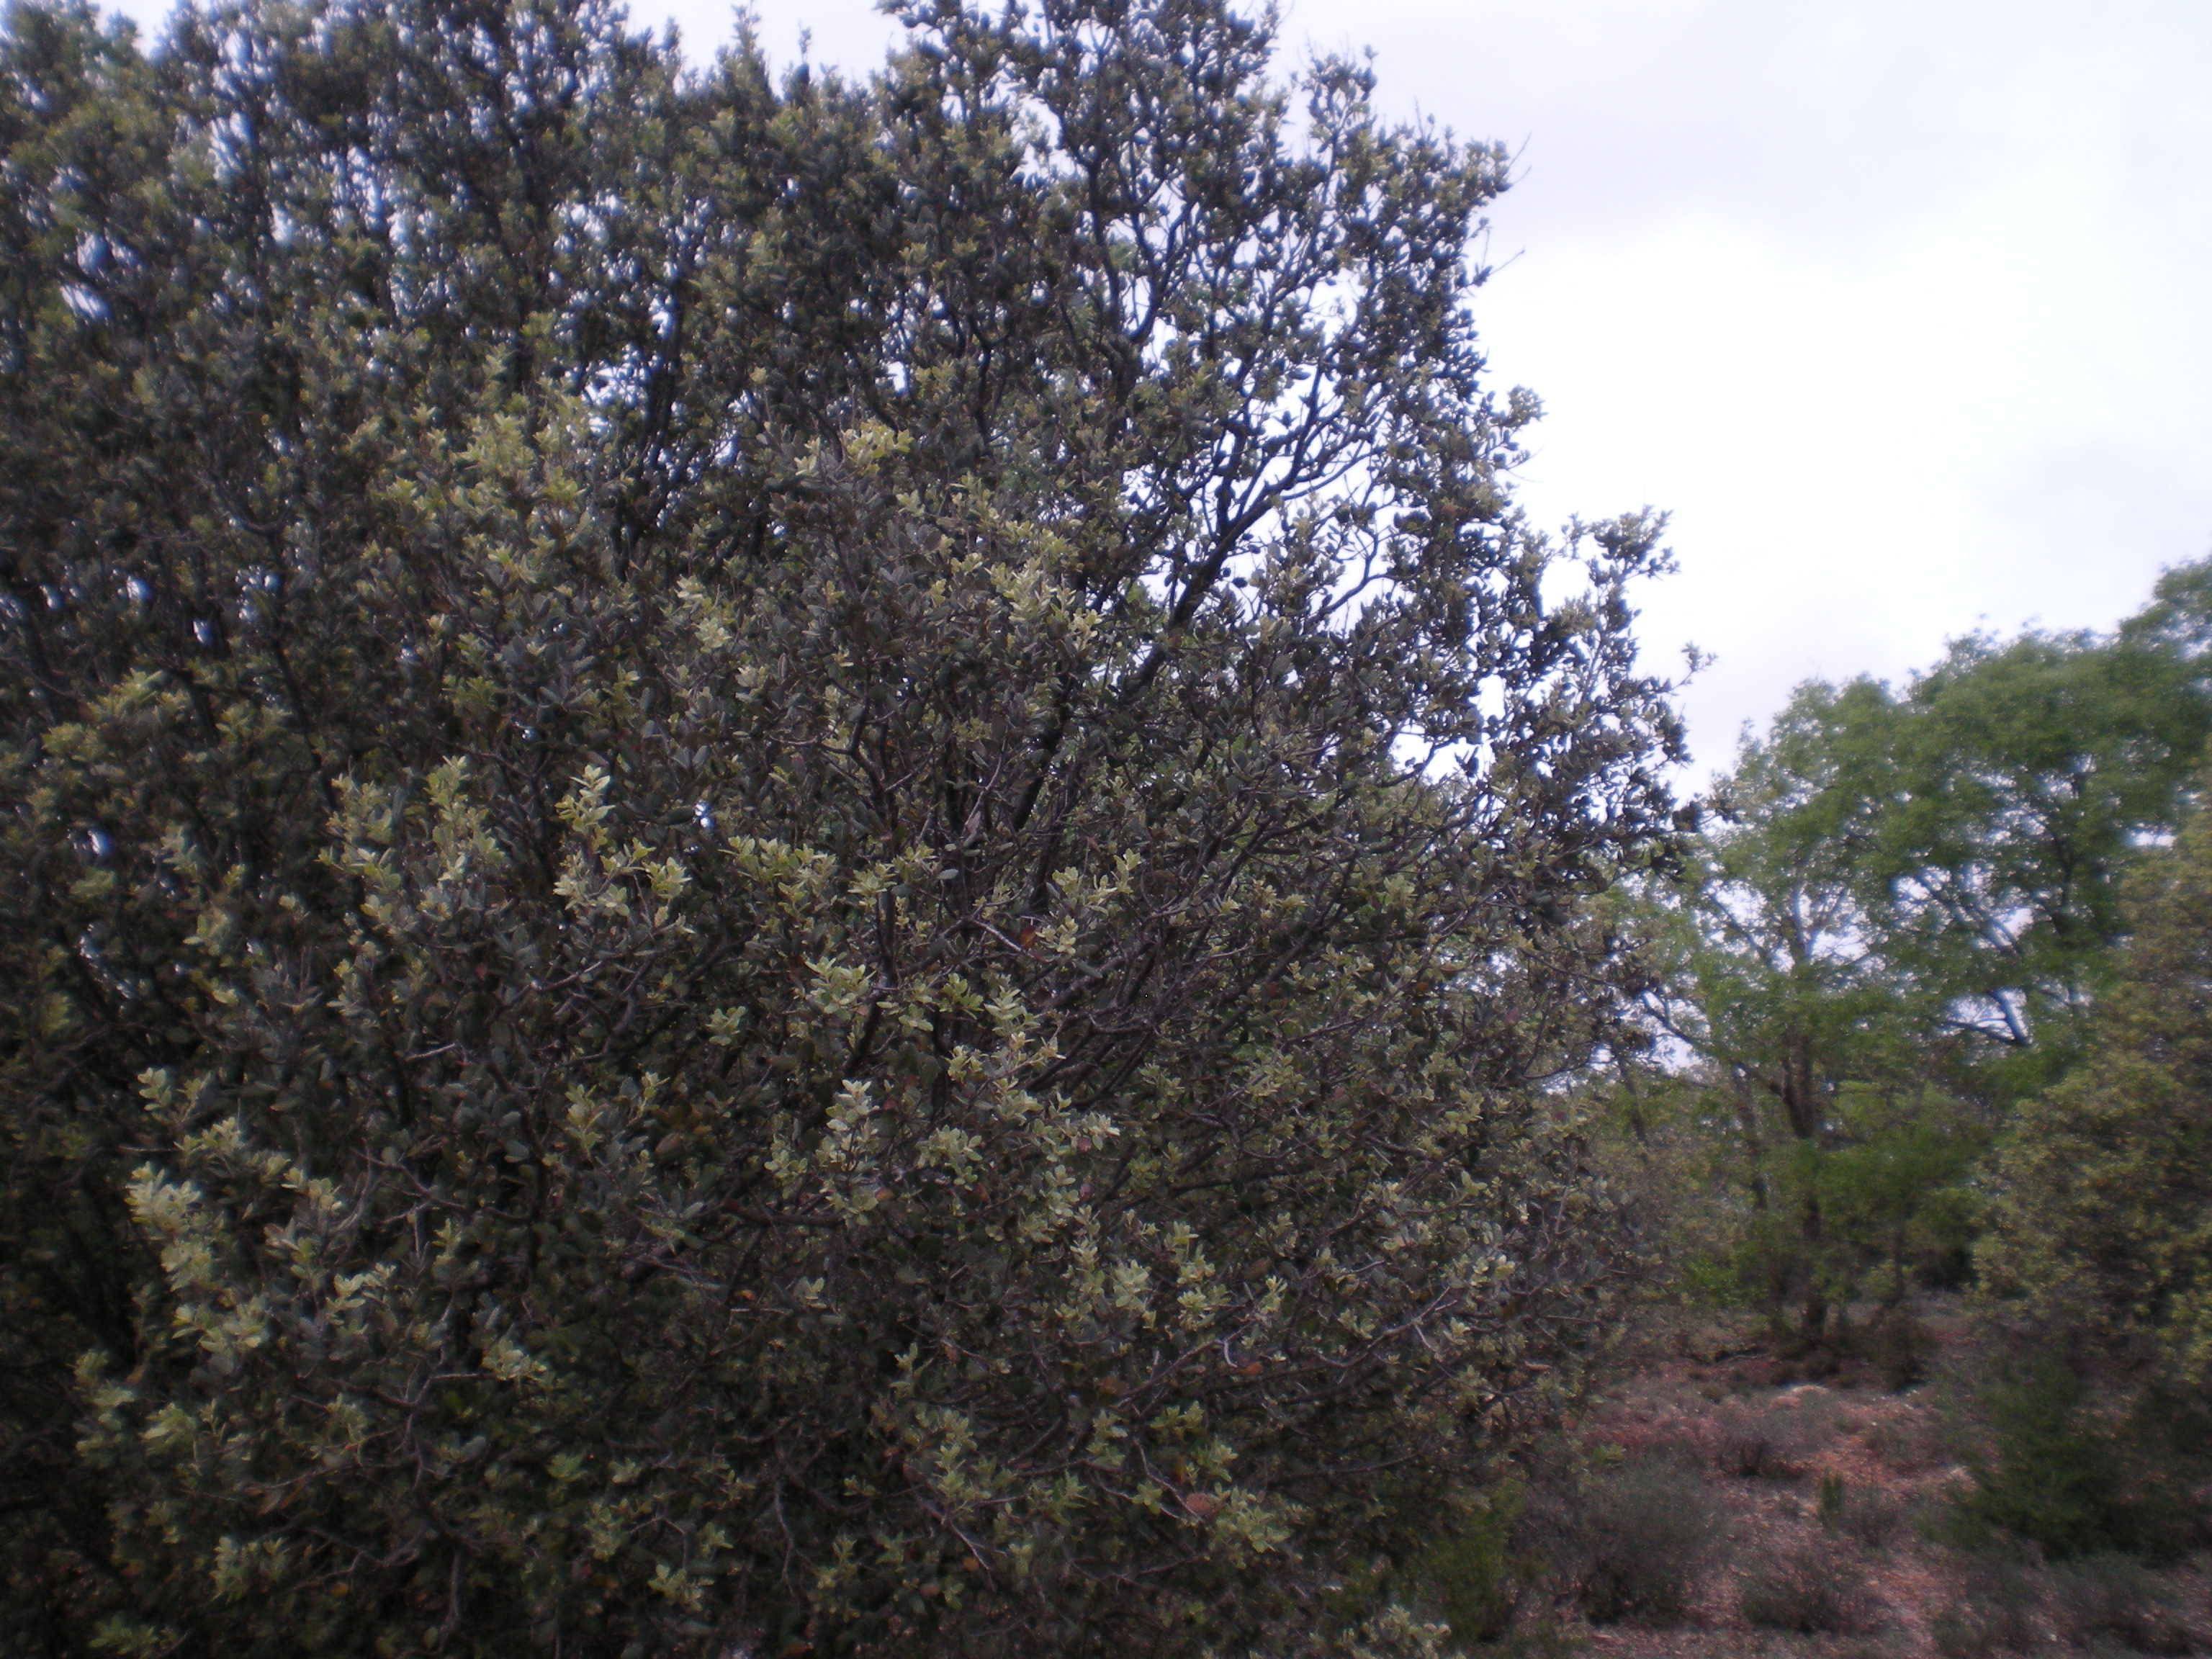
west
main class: Woodland
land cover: Broadleaved woodland
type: broadleaved evergreen forest
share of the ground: 50 - 75 %
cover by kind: shrubs 50 %, unconsolidated bare surface 35 %, broadleaved forest trees 15 %
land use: Other primary production
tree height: < 5 m
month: May
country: ES
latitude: 38.8413
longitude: -2.9224
